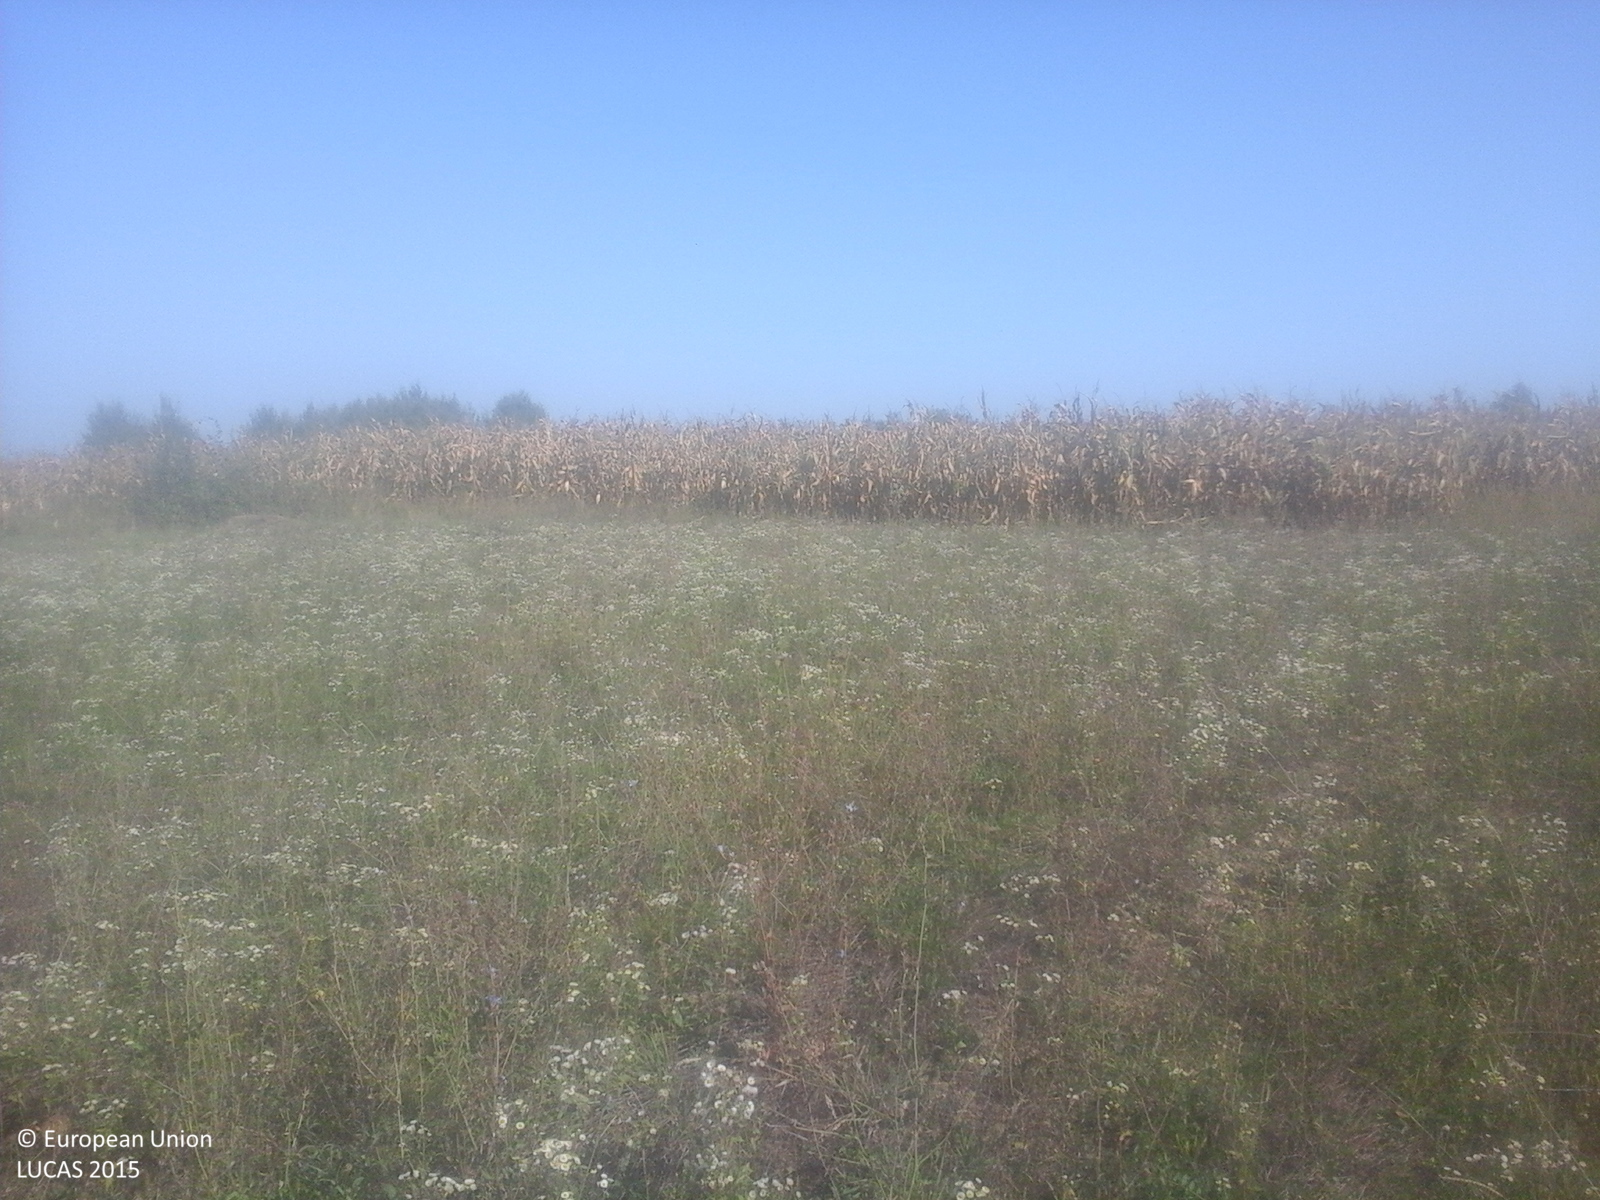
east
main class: Grassland
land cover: Grassland without tree/shrub cover
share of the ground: > 75 %
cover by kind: herbaceous plants 100 %
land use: Agriculture (excluding fallow land and kitchen gardens)
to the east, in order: Grassland without tree/shrub cover; Maize; Grassland without tree/shrub cover; Tracks; Grassland without tree/shrub cover; Tracks; Maize; Spontaneously vegetated surfaces; Tracks; Spontaneously vegetated surfaces; Grassland with sparse tree/shrub cover
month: September
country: RO
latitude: 46.6379
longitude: 22.3160
